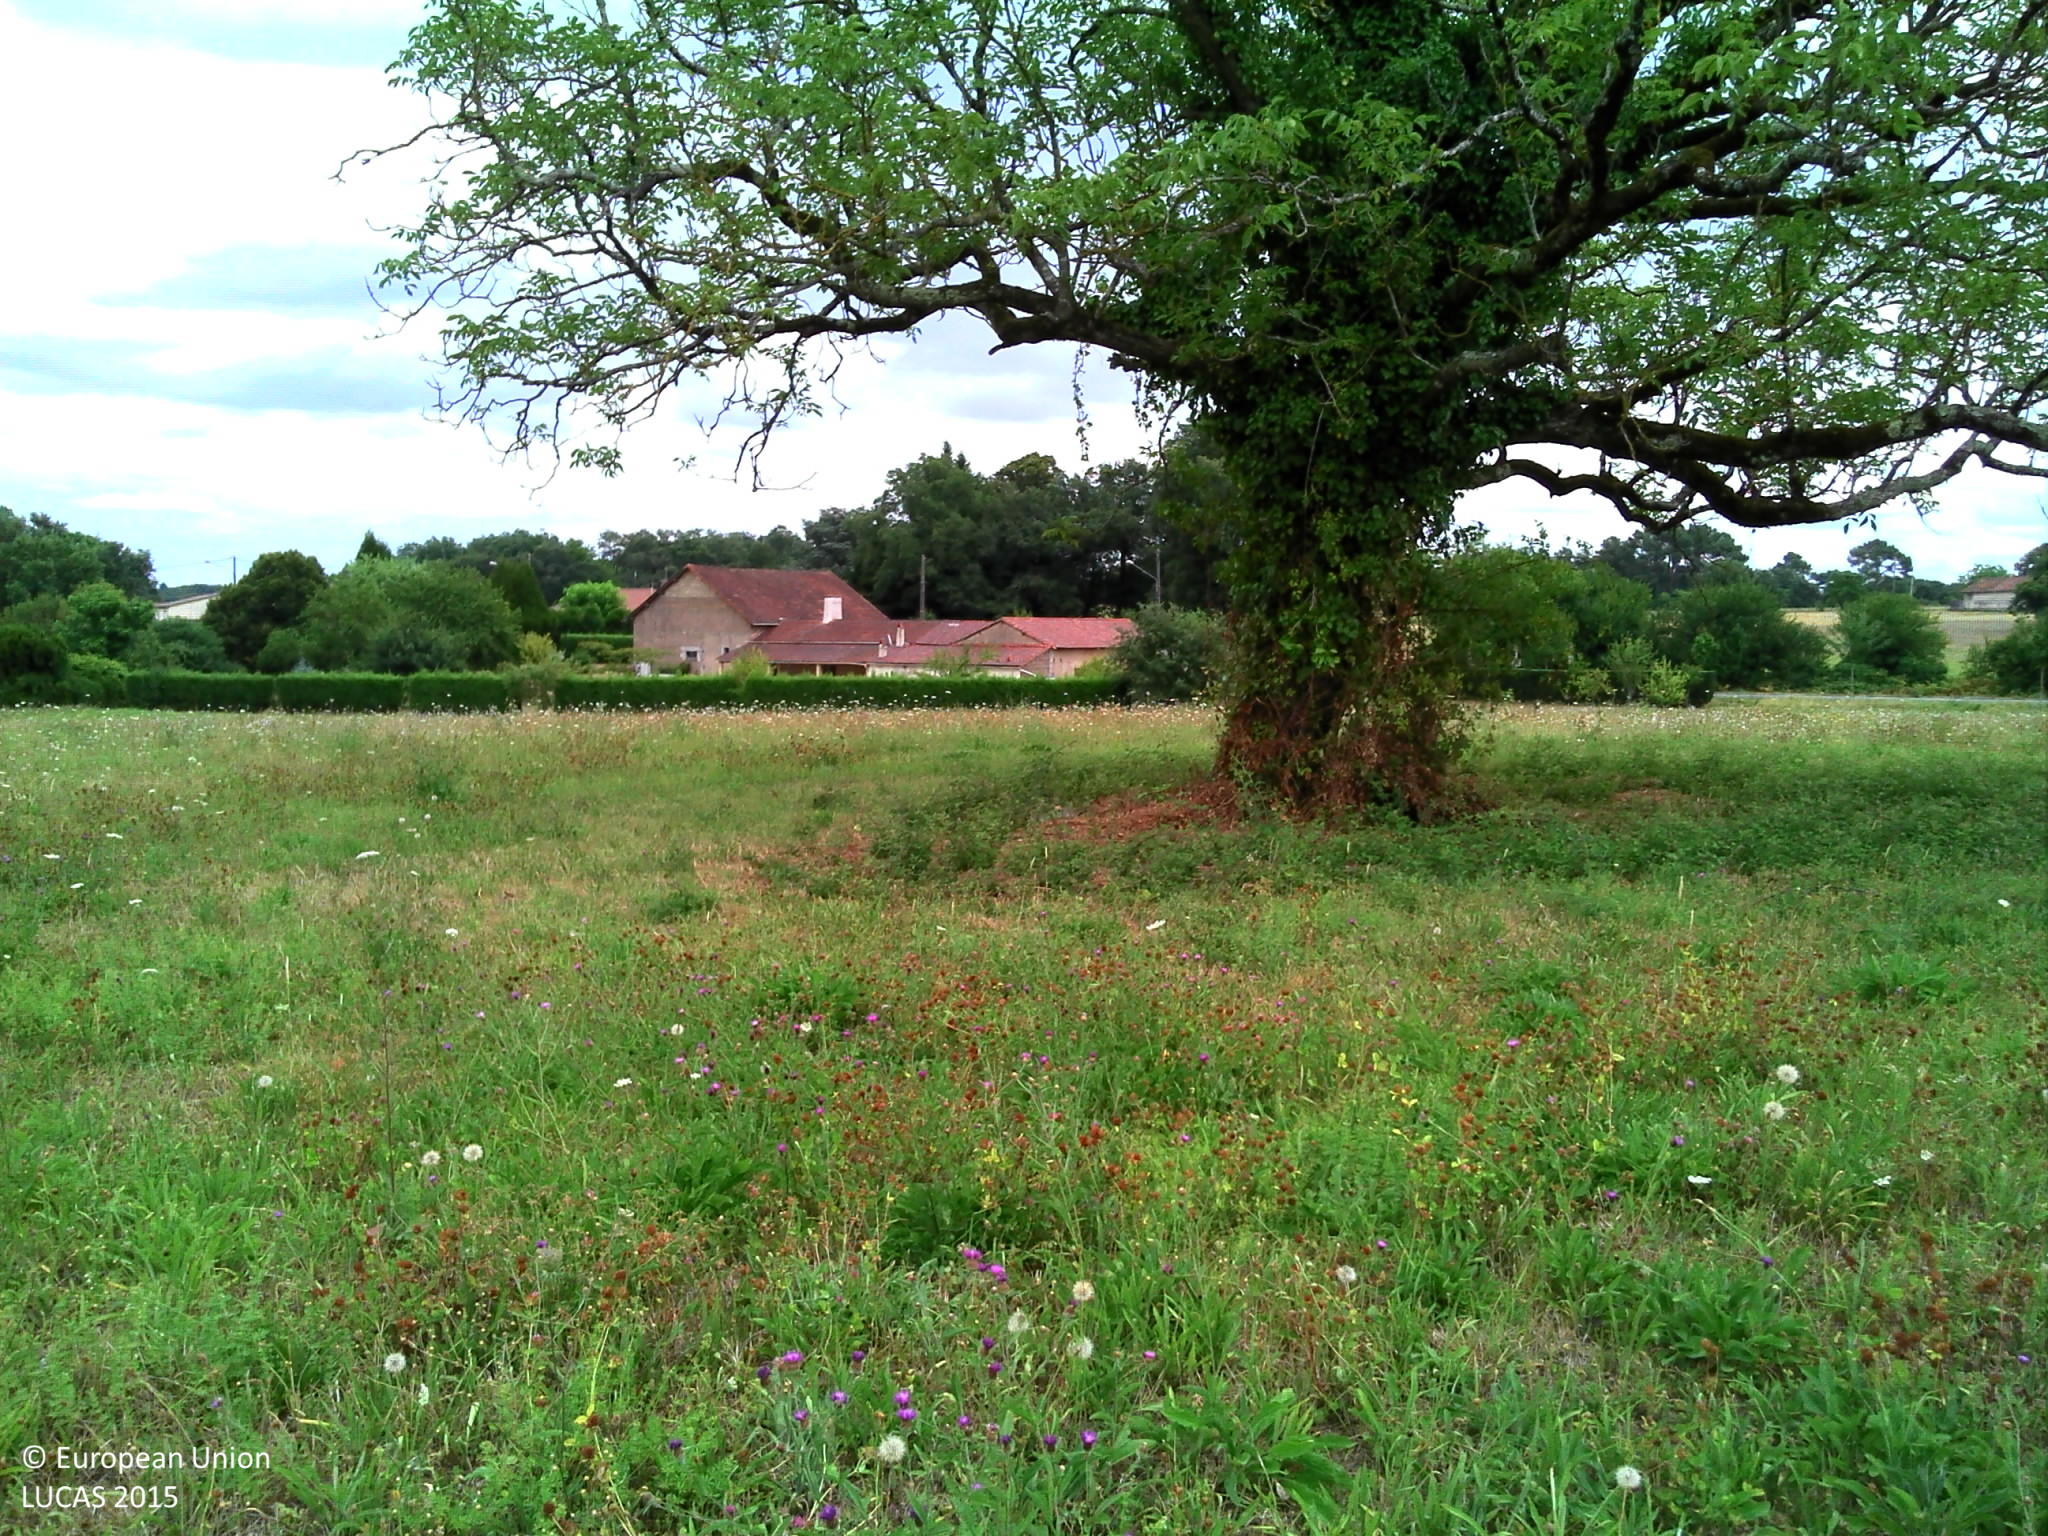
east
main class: Grassland
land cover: Grassland with sparse tree/shrub cover
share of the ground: > 75 %
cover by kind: herbaceous plants 95 %, broadleaved forest trees 5 %
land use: Agriculture (excluding fallow land and kitchen gardens)
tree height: > 5 m
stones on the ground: < 10 %
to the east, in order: Grassland with sparse tree/shrub cover; Grassland without tree/shrub cover; Artificial constructions in urban areas; Grassland without tree/shrub cover
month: July
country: FR
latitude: 45.0777
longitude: 0.7302
